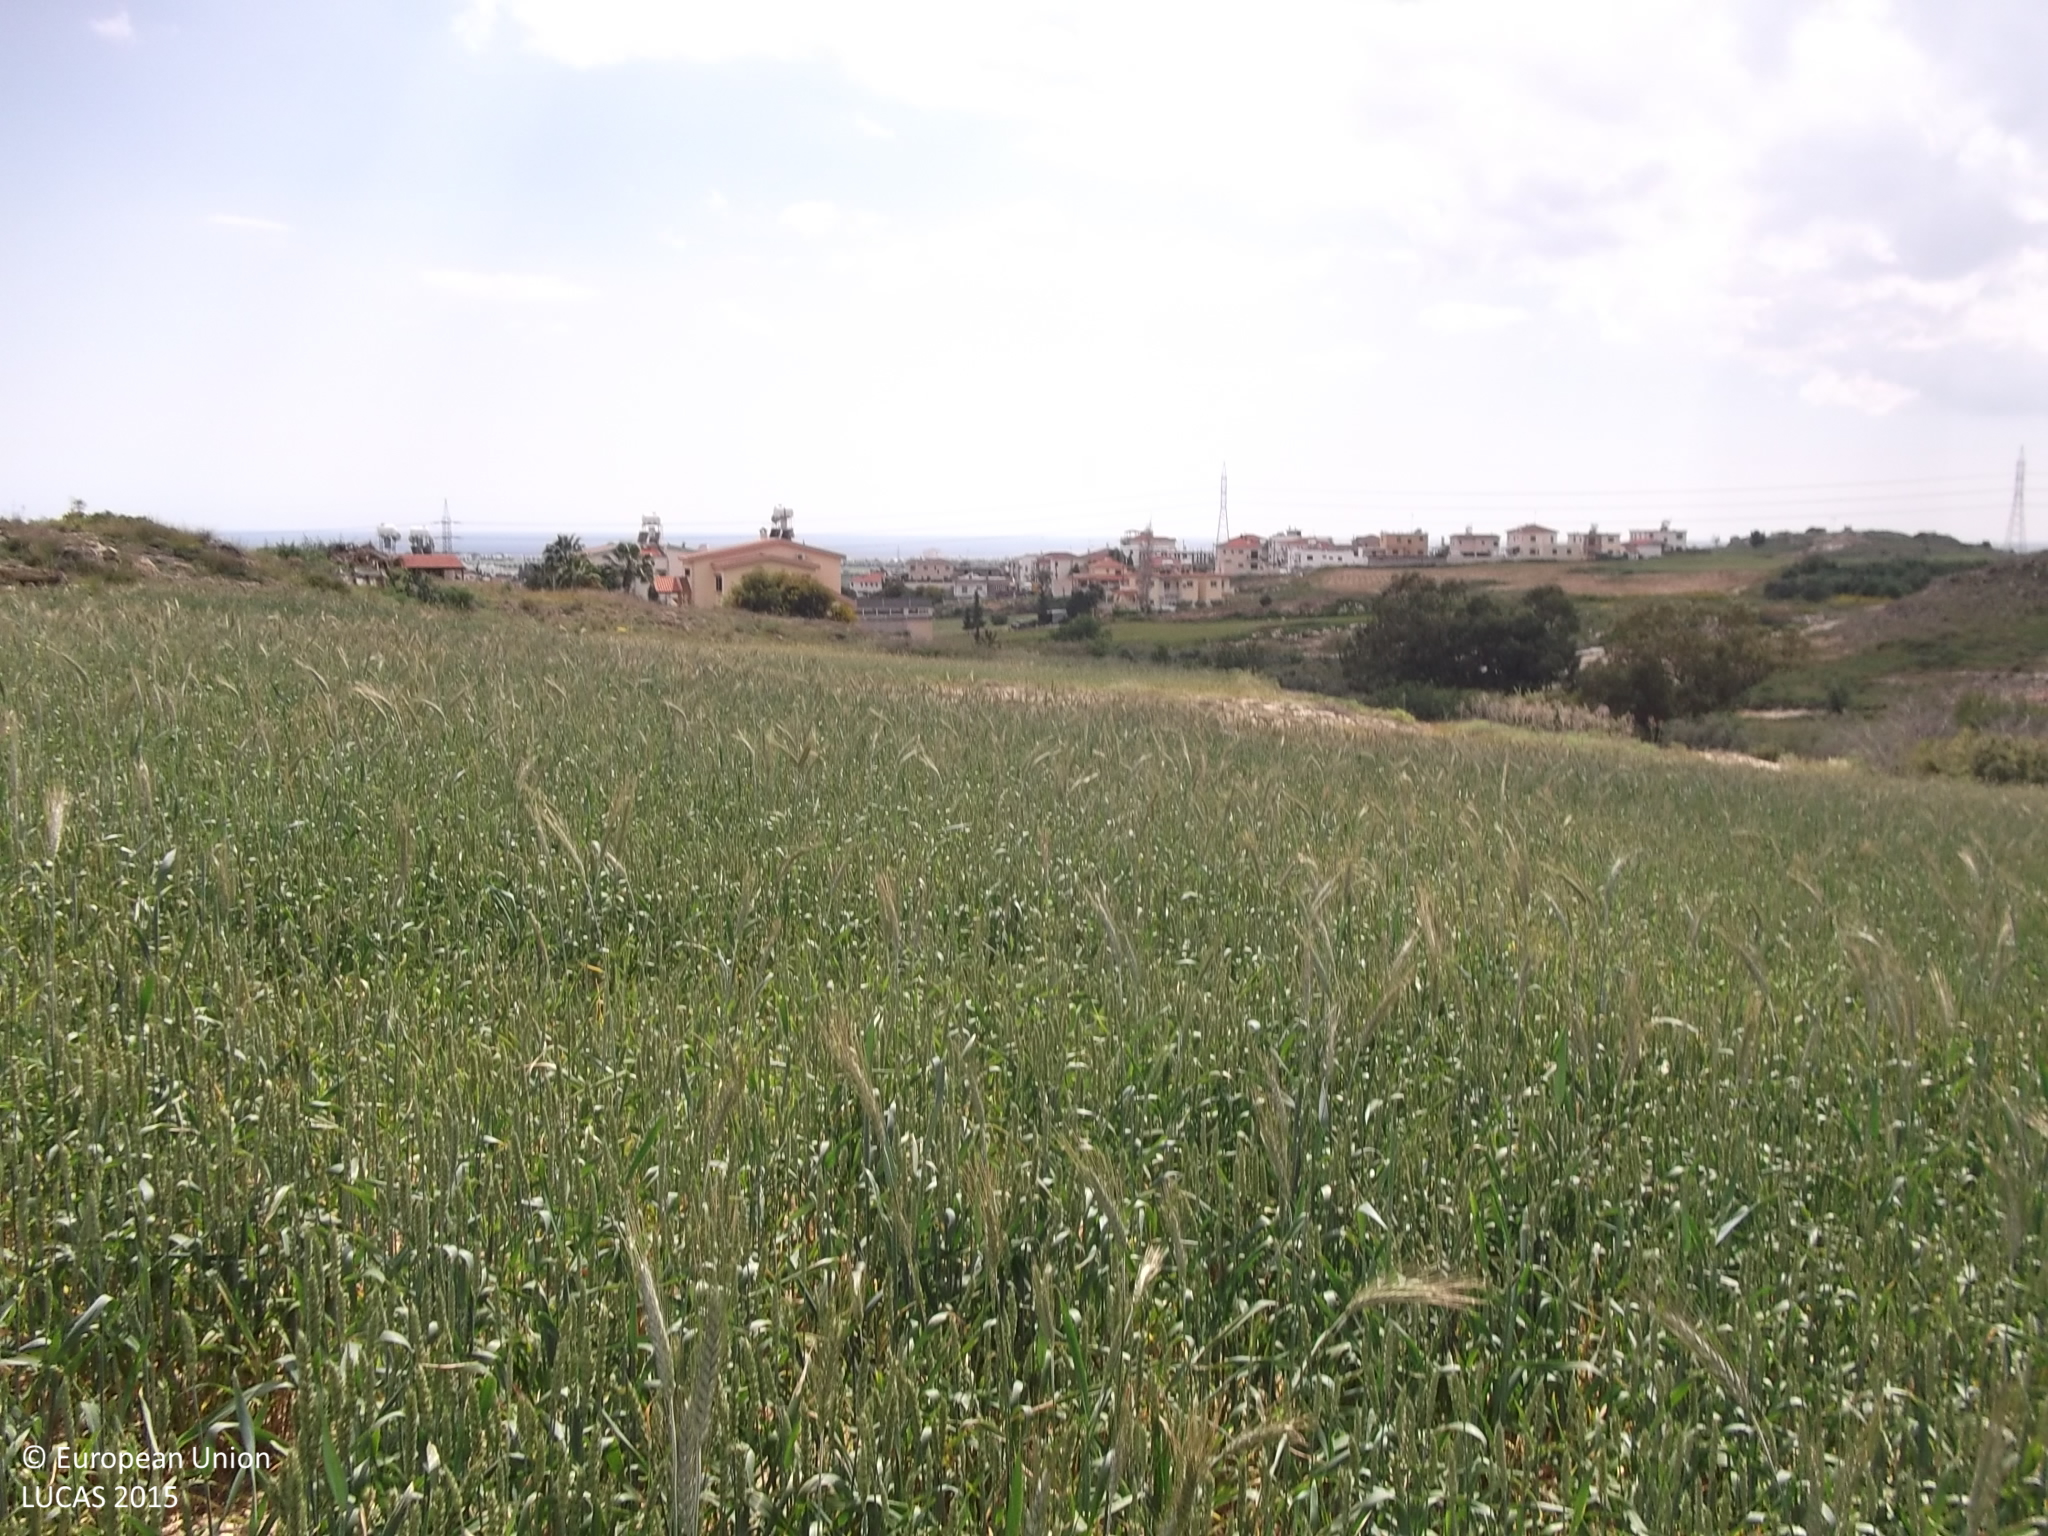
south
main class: Cropland
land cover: Common wheat
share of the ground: > 75 %
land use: Agriculture (excluding fallow land and kitchen gardens)
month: April
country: CY
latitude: 35.0103
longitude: 33.6853
